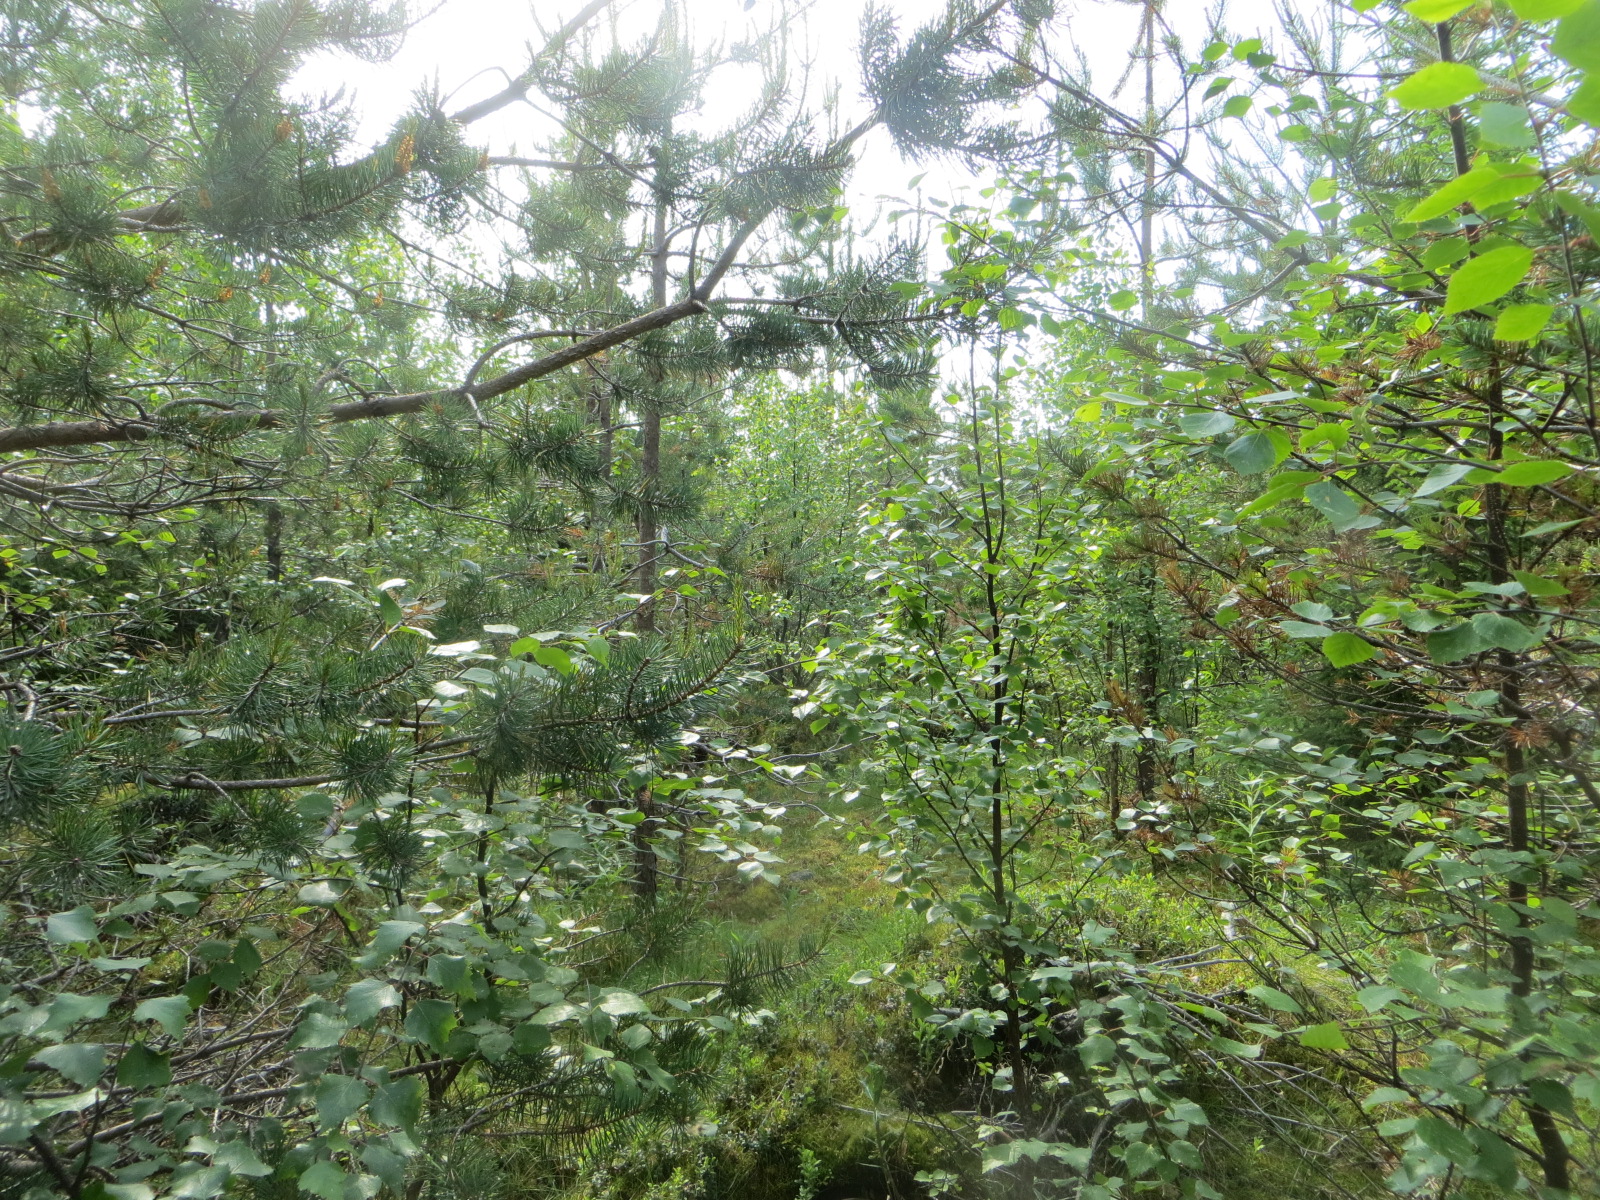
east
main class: Woodland
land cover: Pine dominated mixed woodland
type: boreal forest
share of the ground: > 75 %
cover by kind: coniferous forest trees 50 %, broadleaved forest trees 35 %, shrubs 5 %, herbaceous plants 5 %, lichens and mosses 5 %
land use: Forestry
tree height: > 5 m
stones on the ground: 25 - 50 %
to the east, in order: Pine dominated mixed woodland; Ditches and canals; Pine dominated mixed woodland
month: July
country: FI
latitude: 65.5065
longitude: 25.7994
